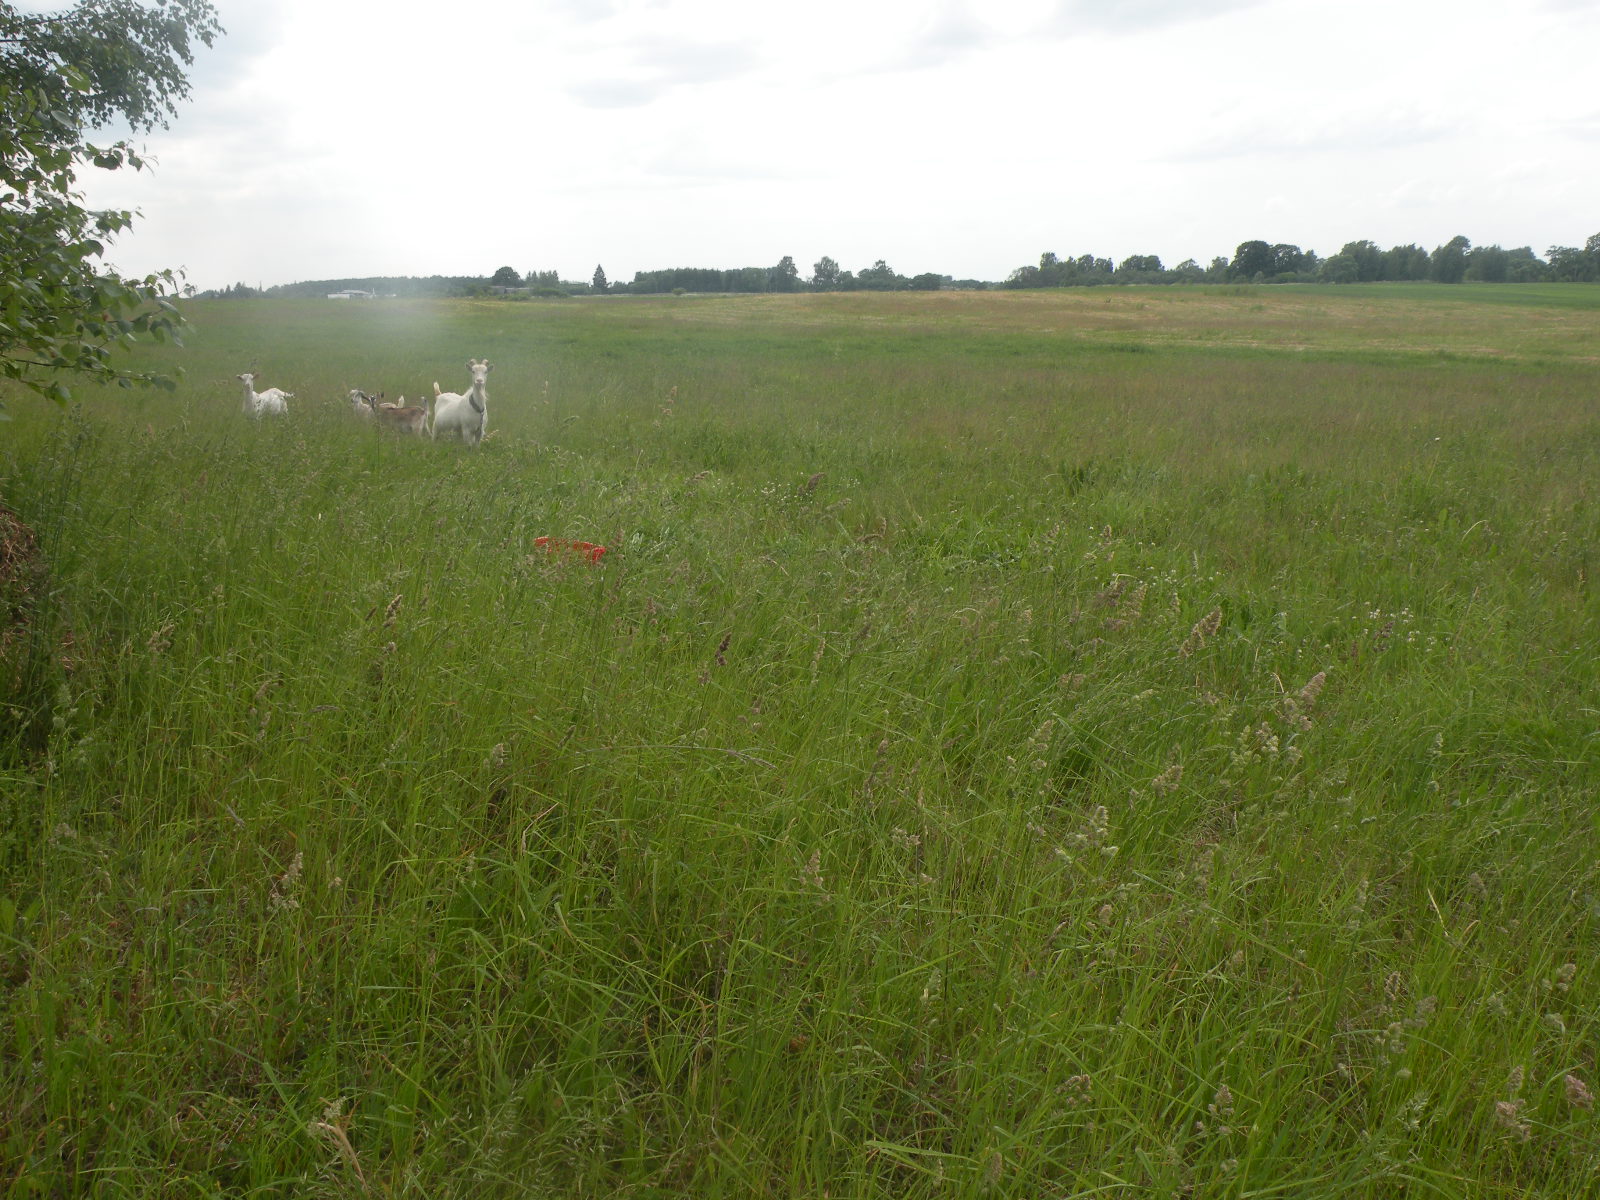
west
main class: Grassland
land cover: Grassland without tree/shrub cover
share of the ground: > 75 %
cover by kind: herbaceous plants 100 %
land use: Agriculture (excluding fallow land and kitchen gardens)
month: June
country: LV
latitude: 56.0516
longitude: 26.7432
